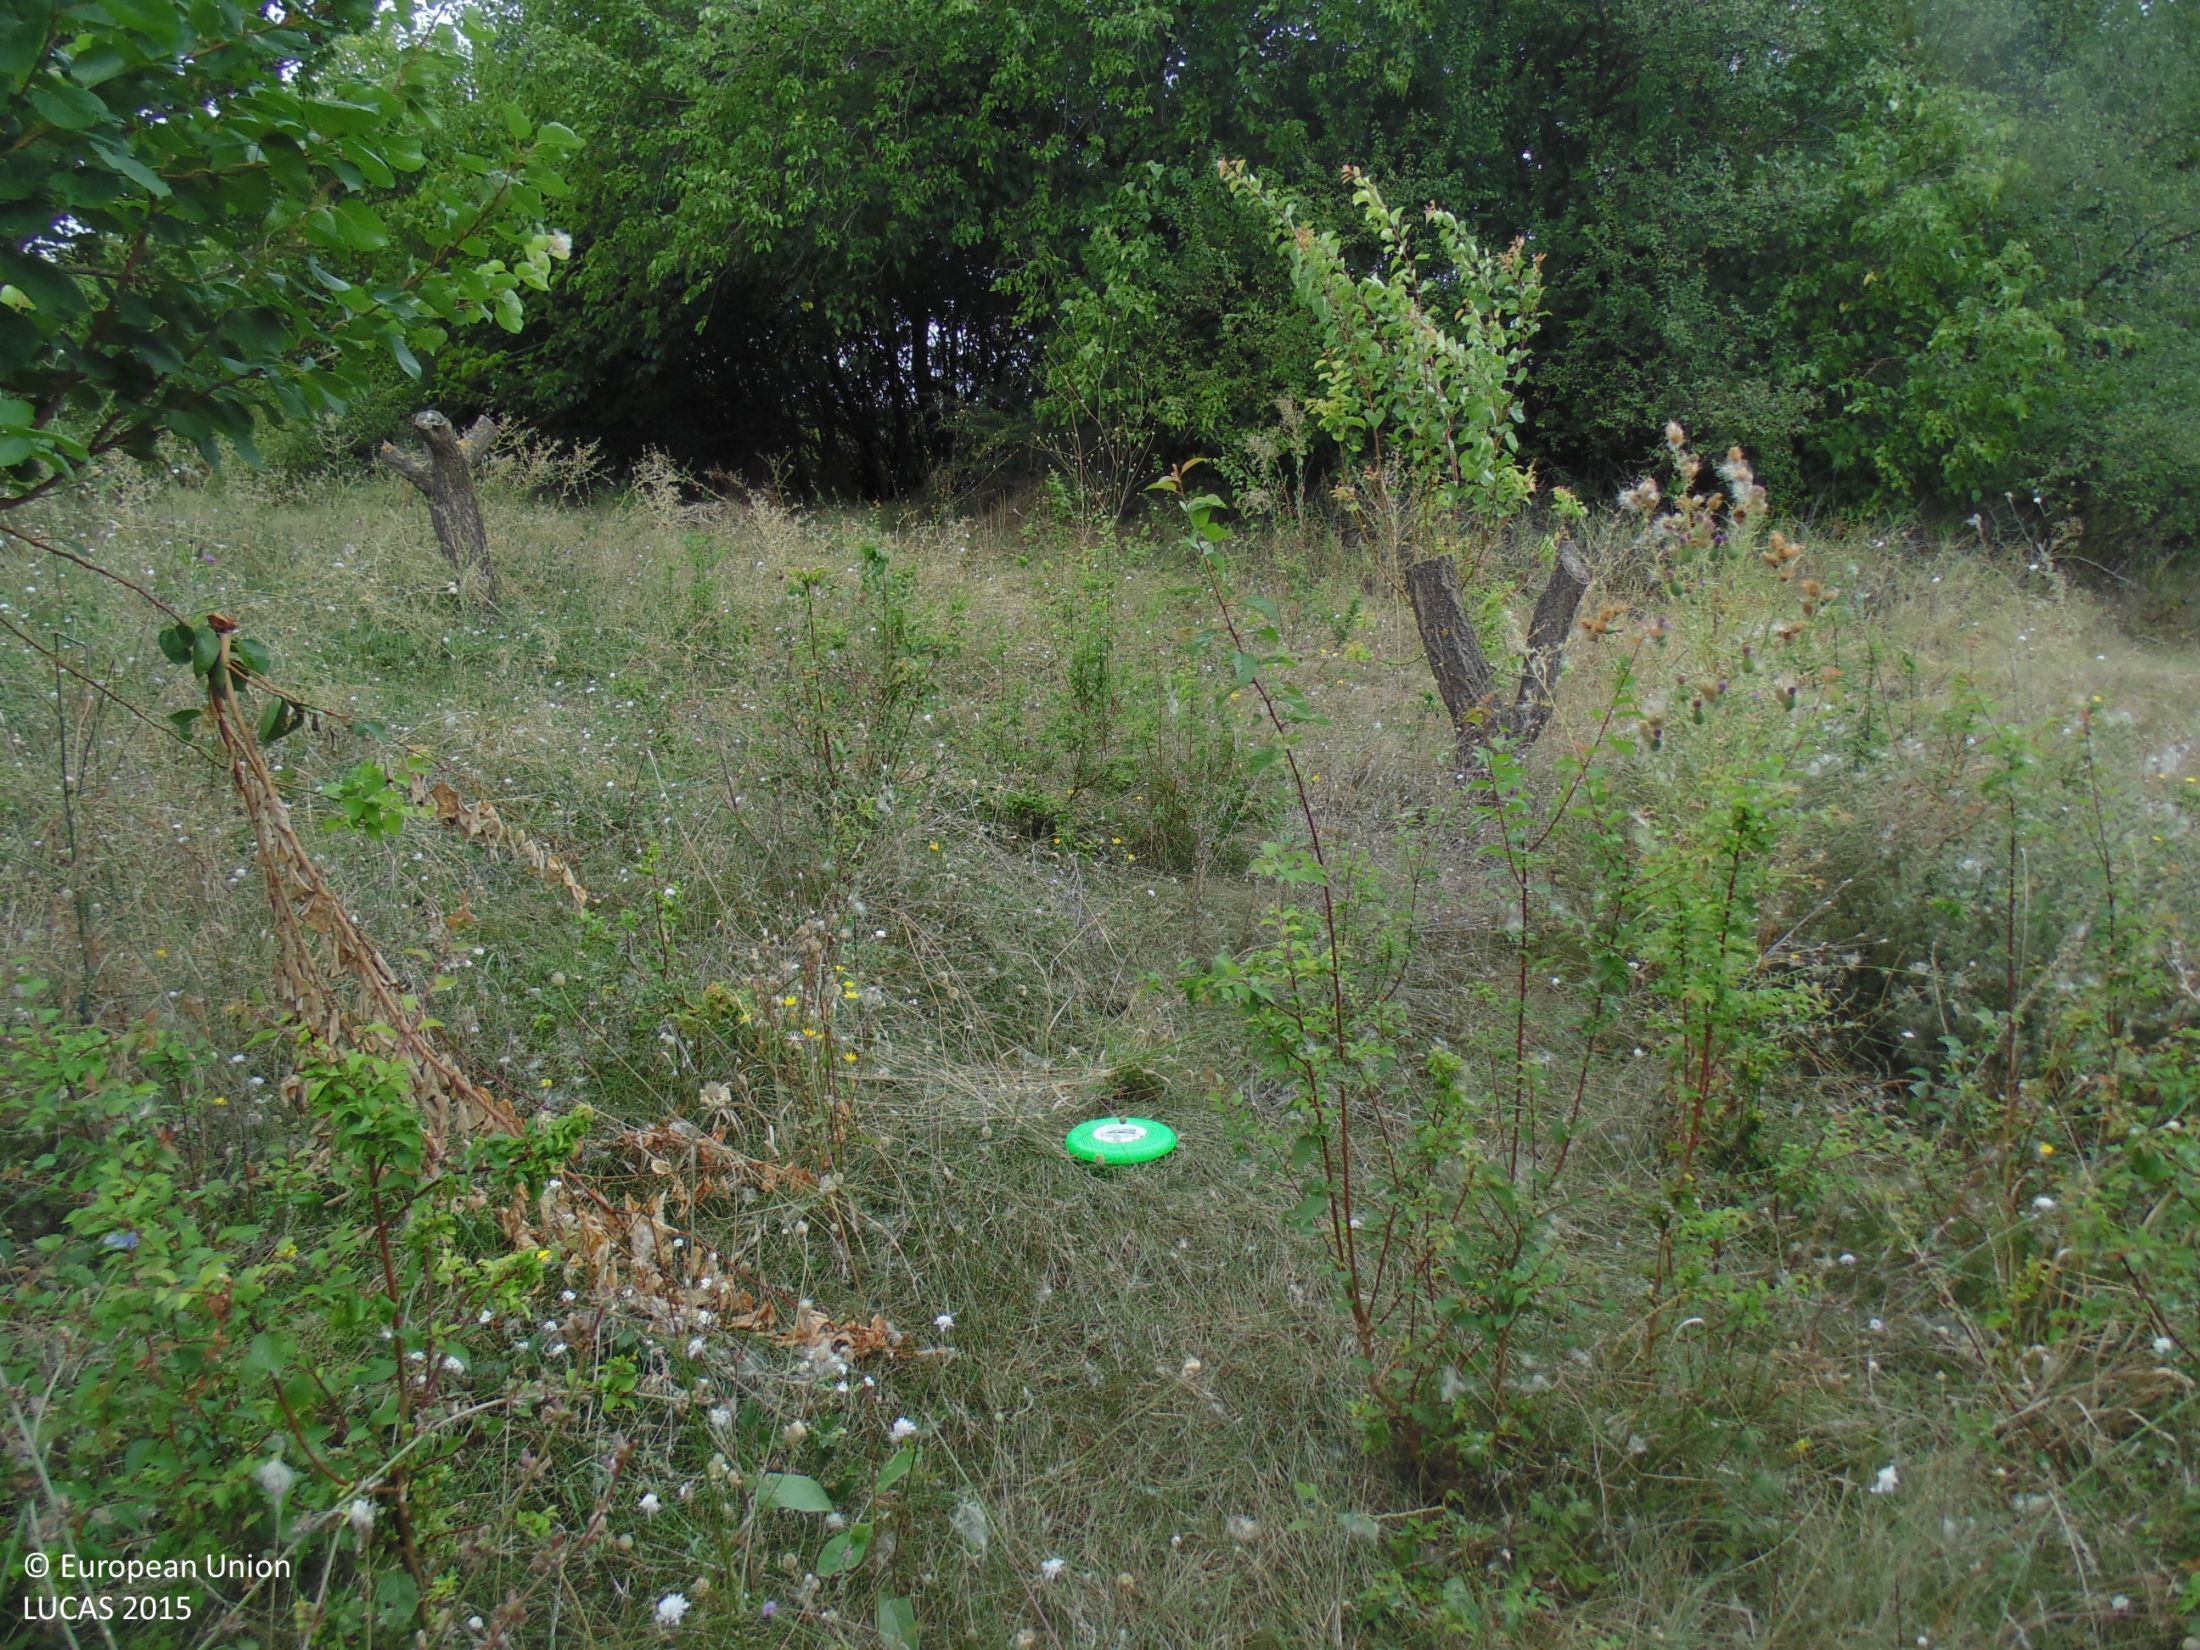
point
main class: Cropland
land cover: Other fruit trees and berries
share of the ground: 50 - 75 %
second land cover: Grassland without tree/shrub cover
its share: > 75 %
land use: Agriculture (excluding fallow land and kitchen gardens)
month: September
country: BG
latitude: 44.0164
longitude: 27.0269
